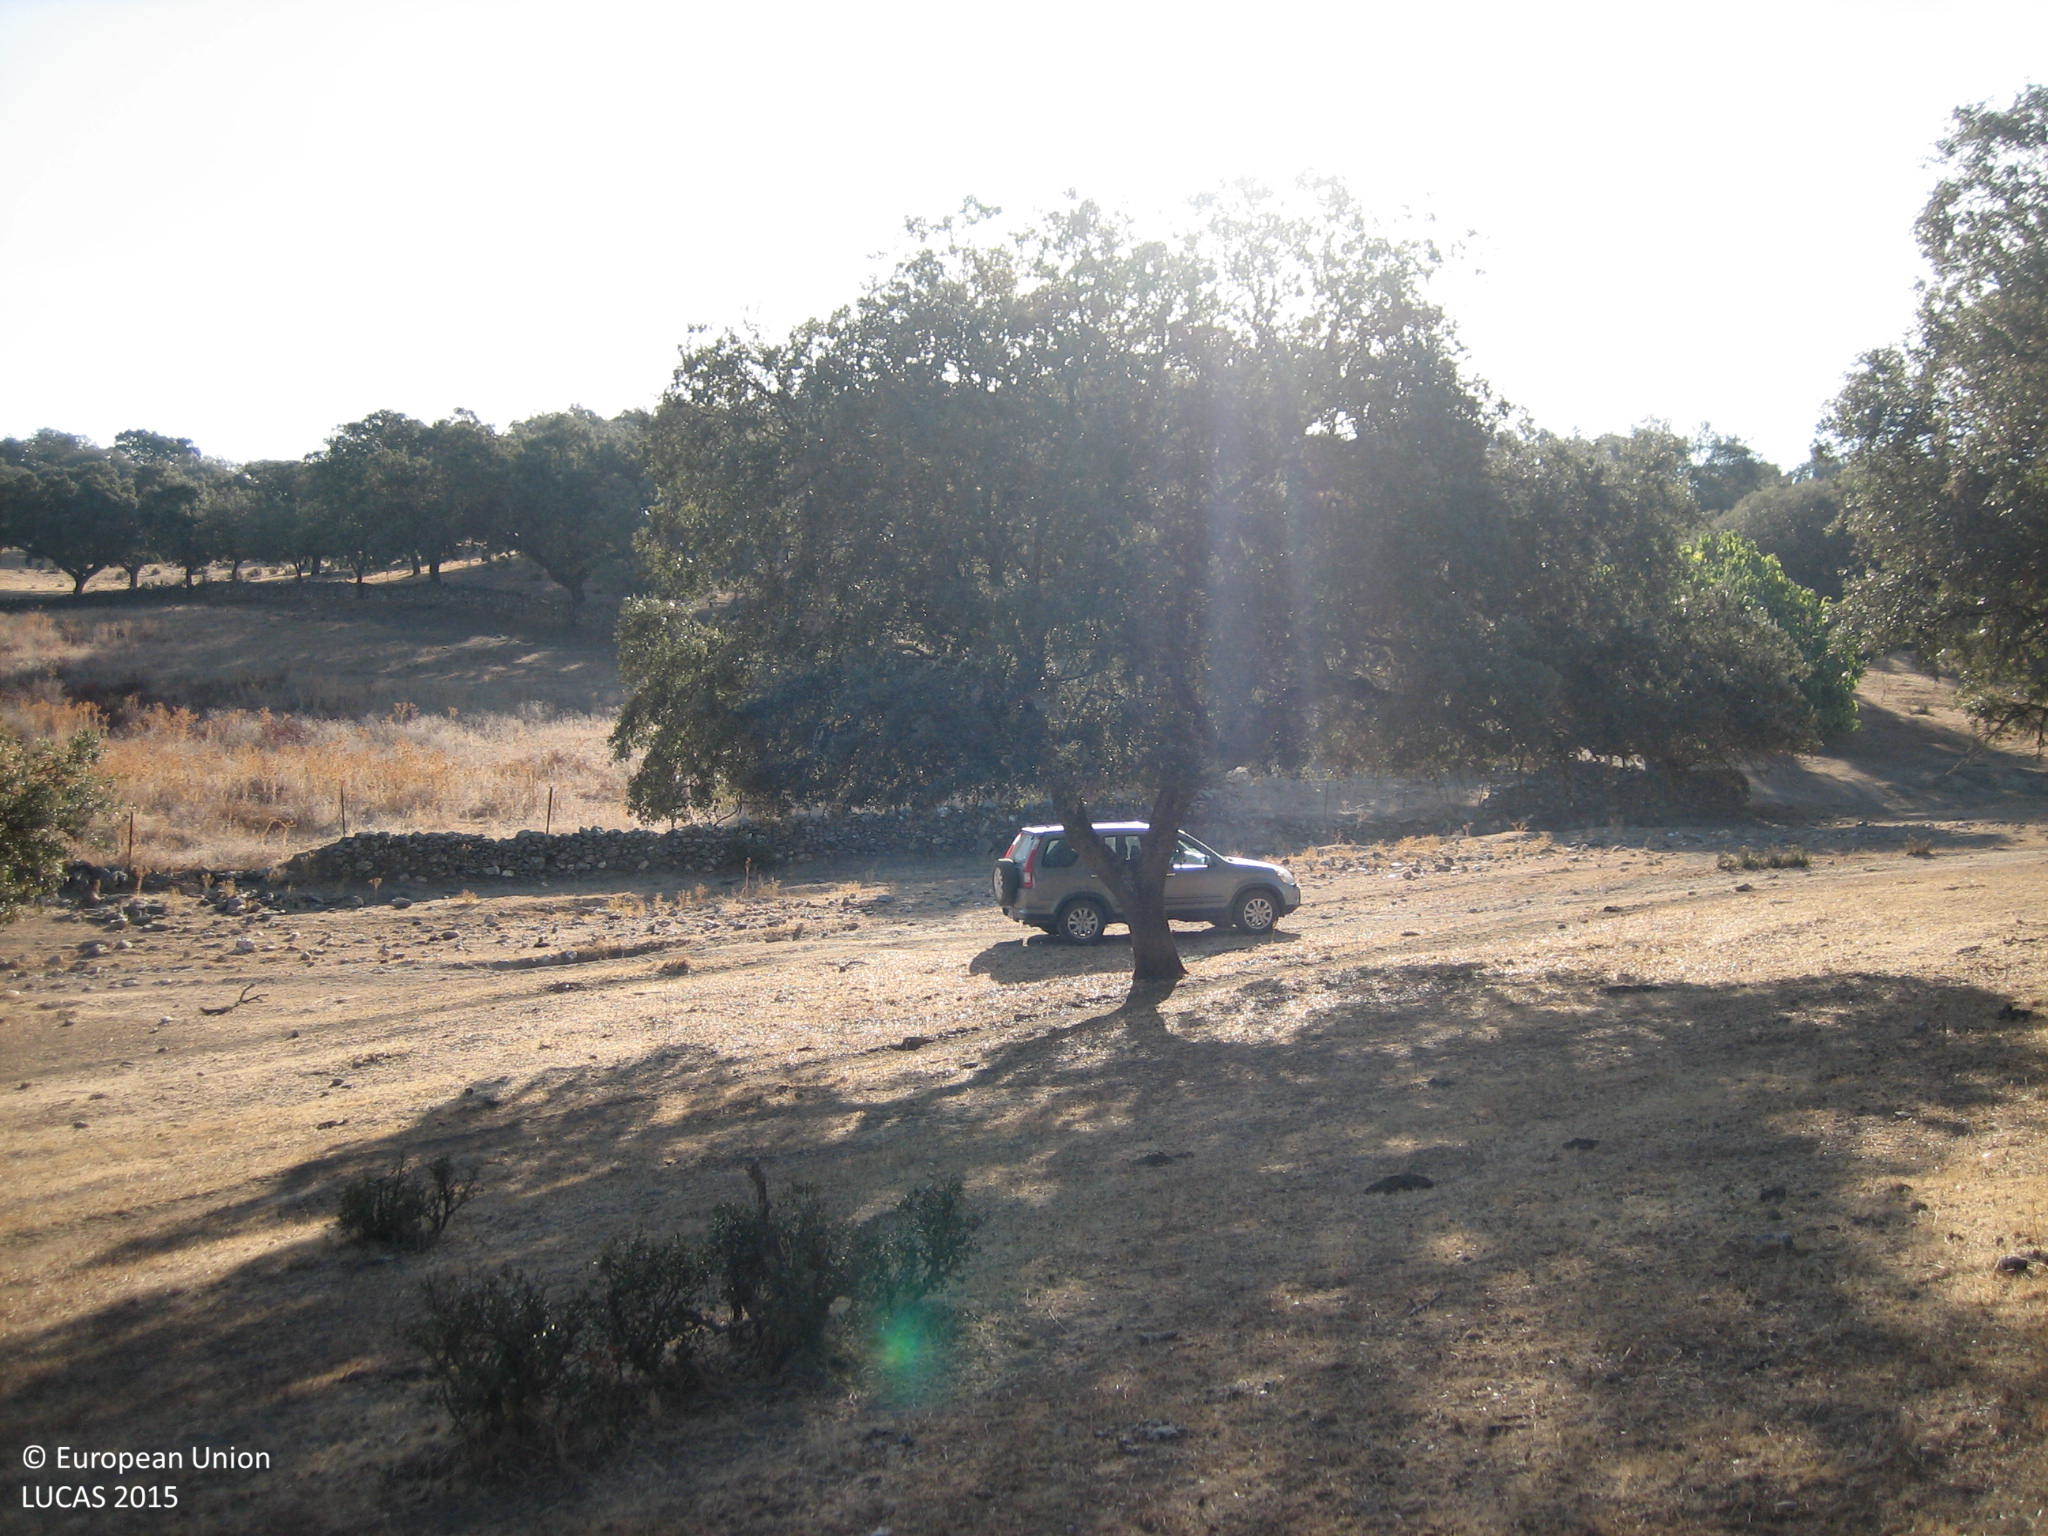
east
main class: Woodland
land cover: Broadleaved woodland
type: broadleaved evergreen forest
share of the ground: 25 - 50 %
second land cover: Grassland without tree/shrub cover
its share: 25 - 50 %
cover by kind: broadleaved forest trees 40 %, herbaceous plants 30 %, unconsolidated bare surface 30 %
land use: Forestry
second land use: Agriculture (excluding fallow land and kitchen gardens)
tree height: > 5 m
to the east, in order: Broadleaved woodland; Grassland without tree/shrub cover; Tracks; Grassland without tree/shrub cover; Fences; Dry stone walls; Other bare soil; Fences; Dry stone walls; Broadleaved woodland; Tracks; Broadleaved woodland
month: August
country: ES
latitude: 38.5725
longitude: -7.1823
